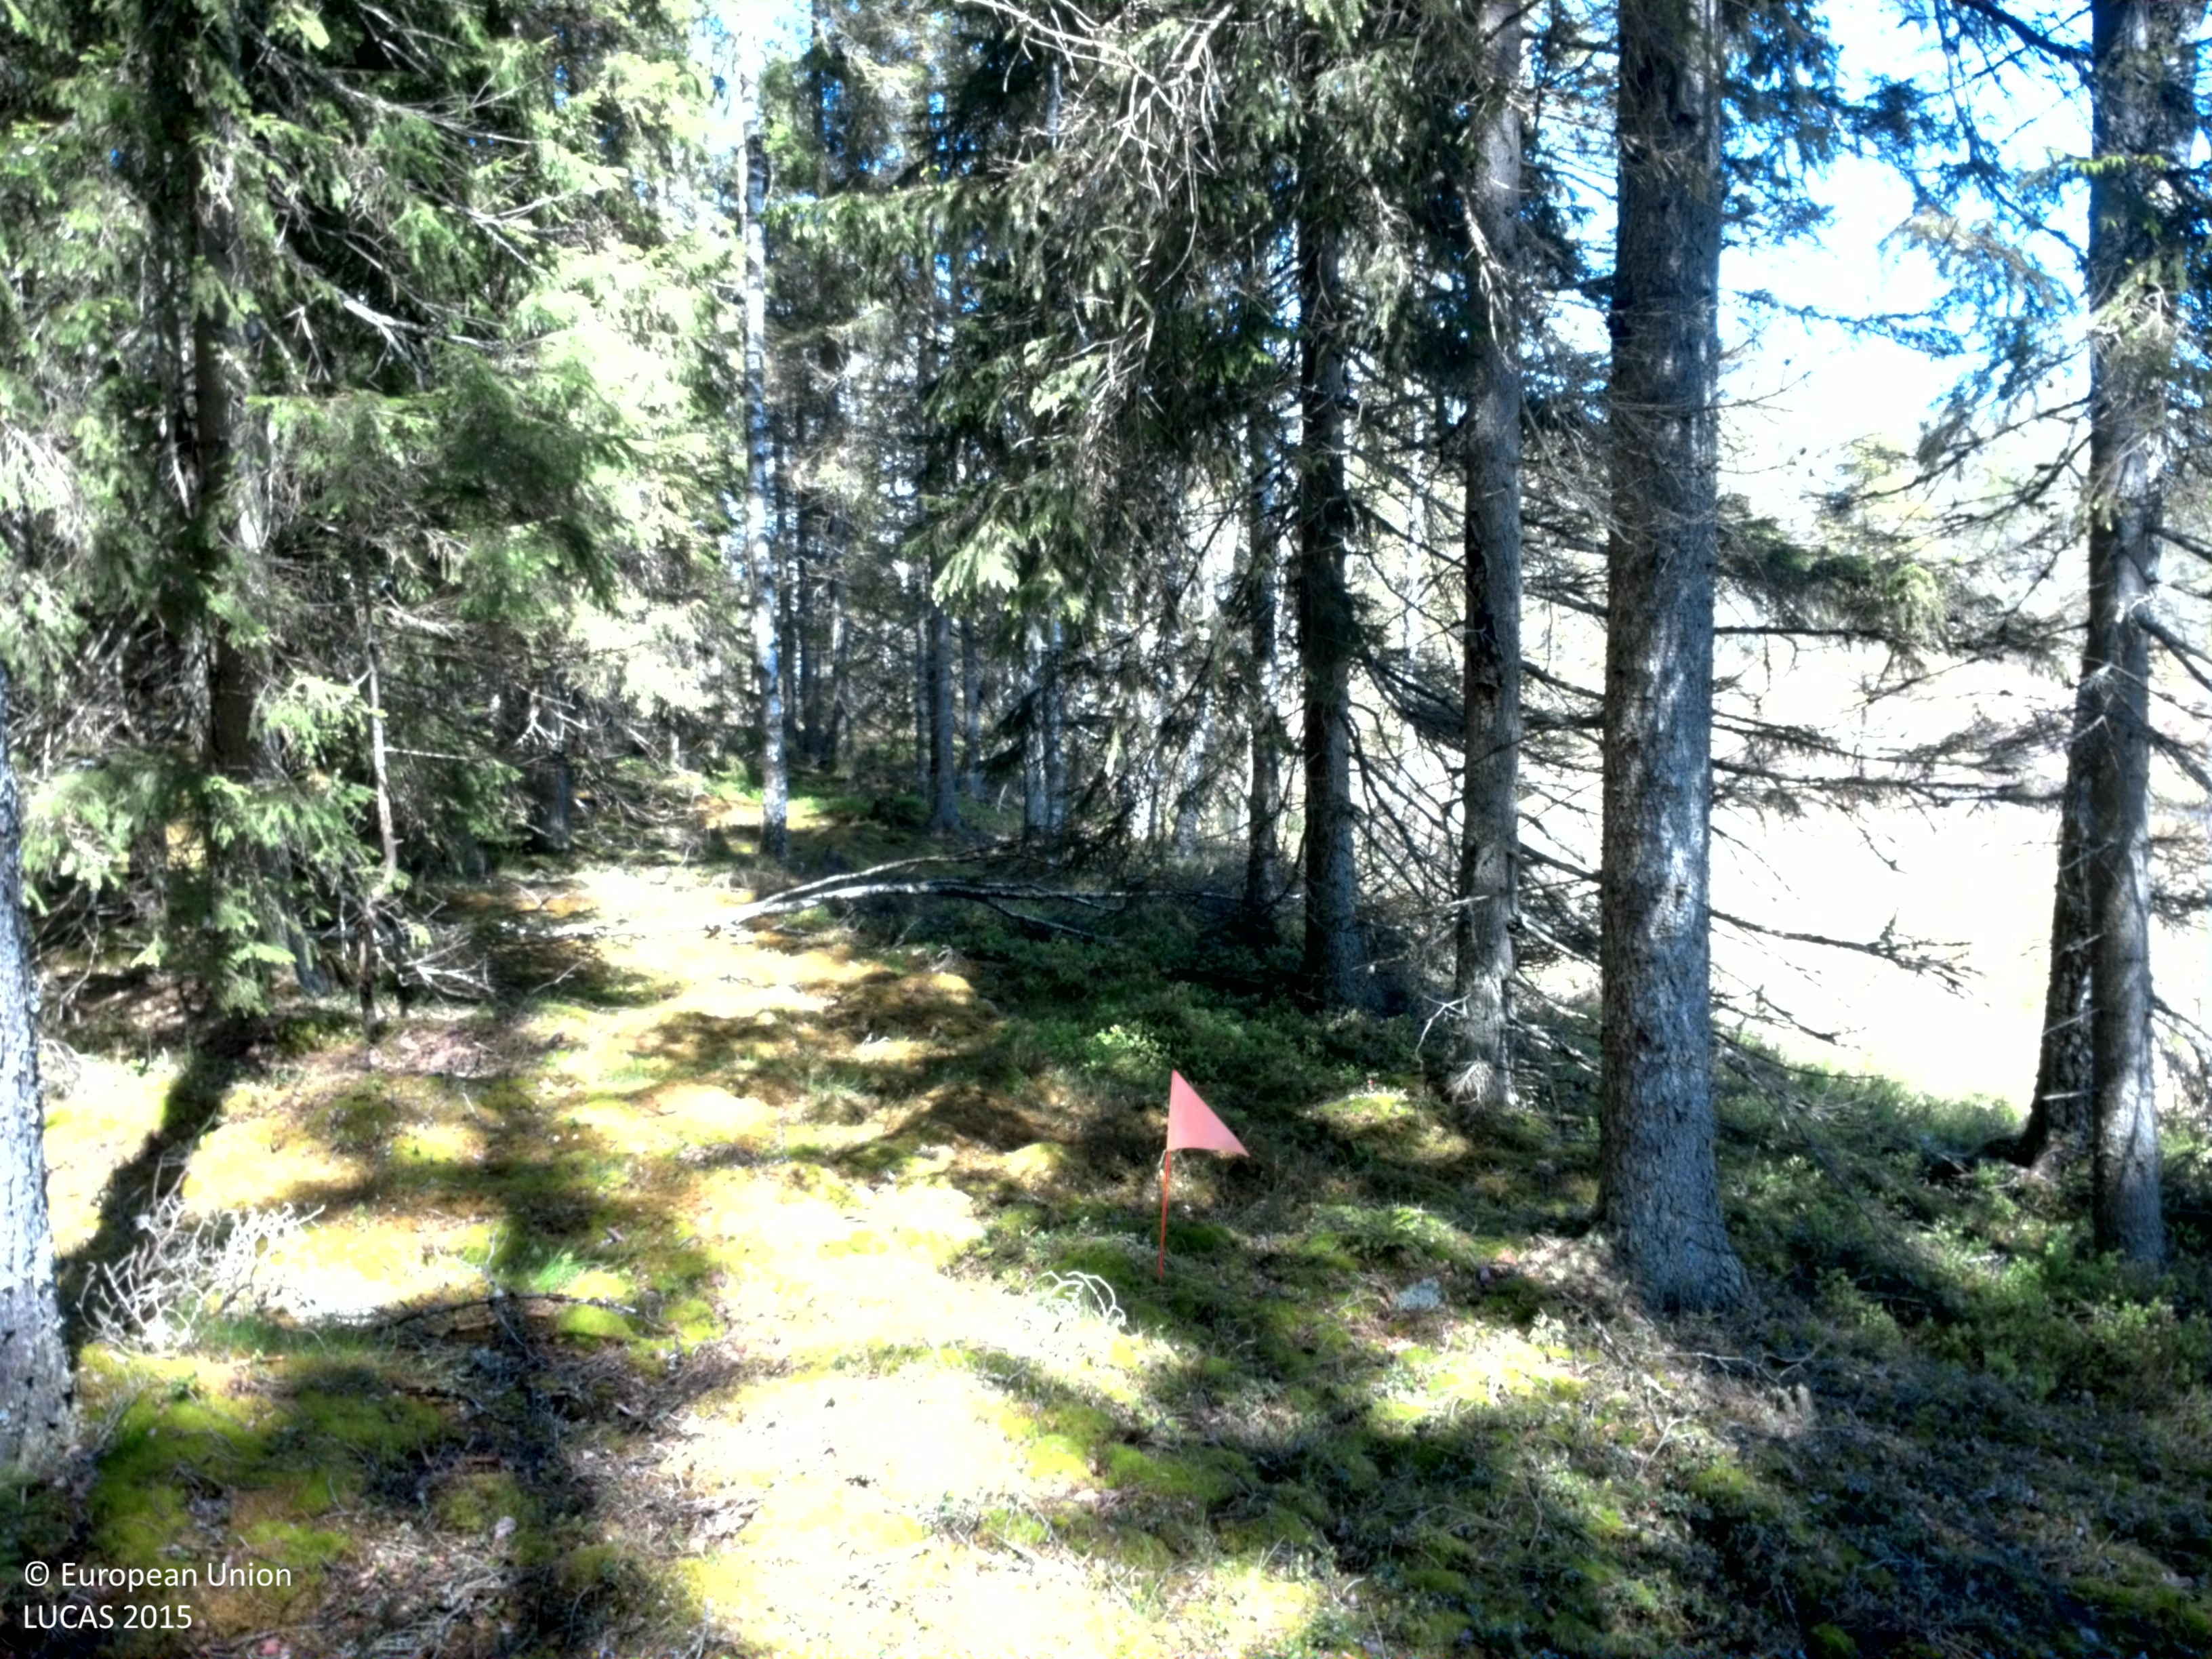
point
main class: Woodland
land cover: Spruce dominated coniferous woodland
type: boreal forest
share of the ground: 50 - 75 %
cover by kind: coniferous forest trees 45 %, lichens and mosses 30 %, broadleaved forest trees 10 %, shrubs 10 %, herbaceous plants 5 %
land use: Forestry
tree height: > 5 m
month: May
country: SE
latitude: 56.8977
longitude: 15.5310
